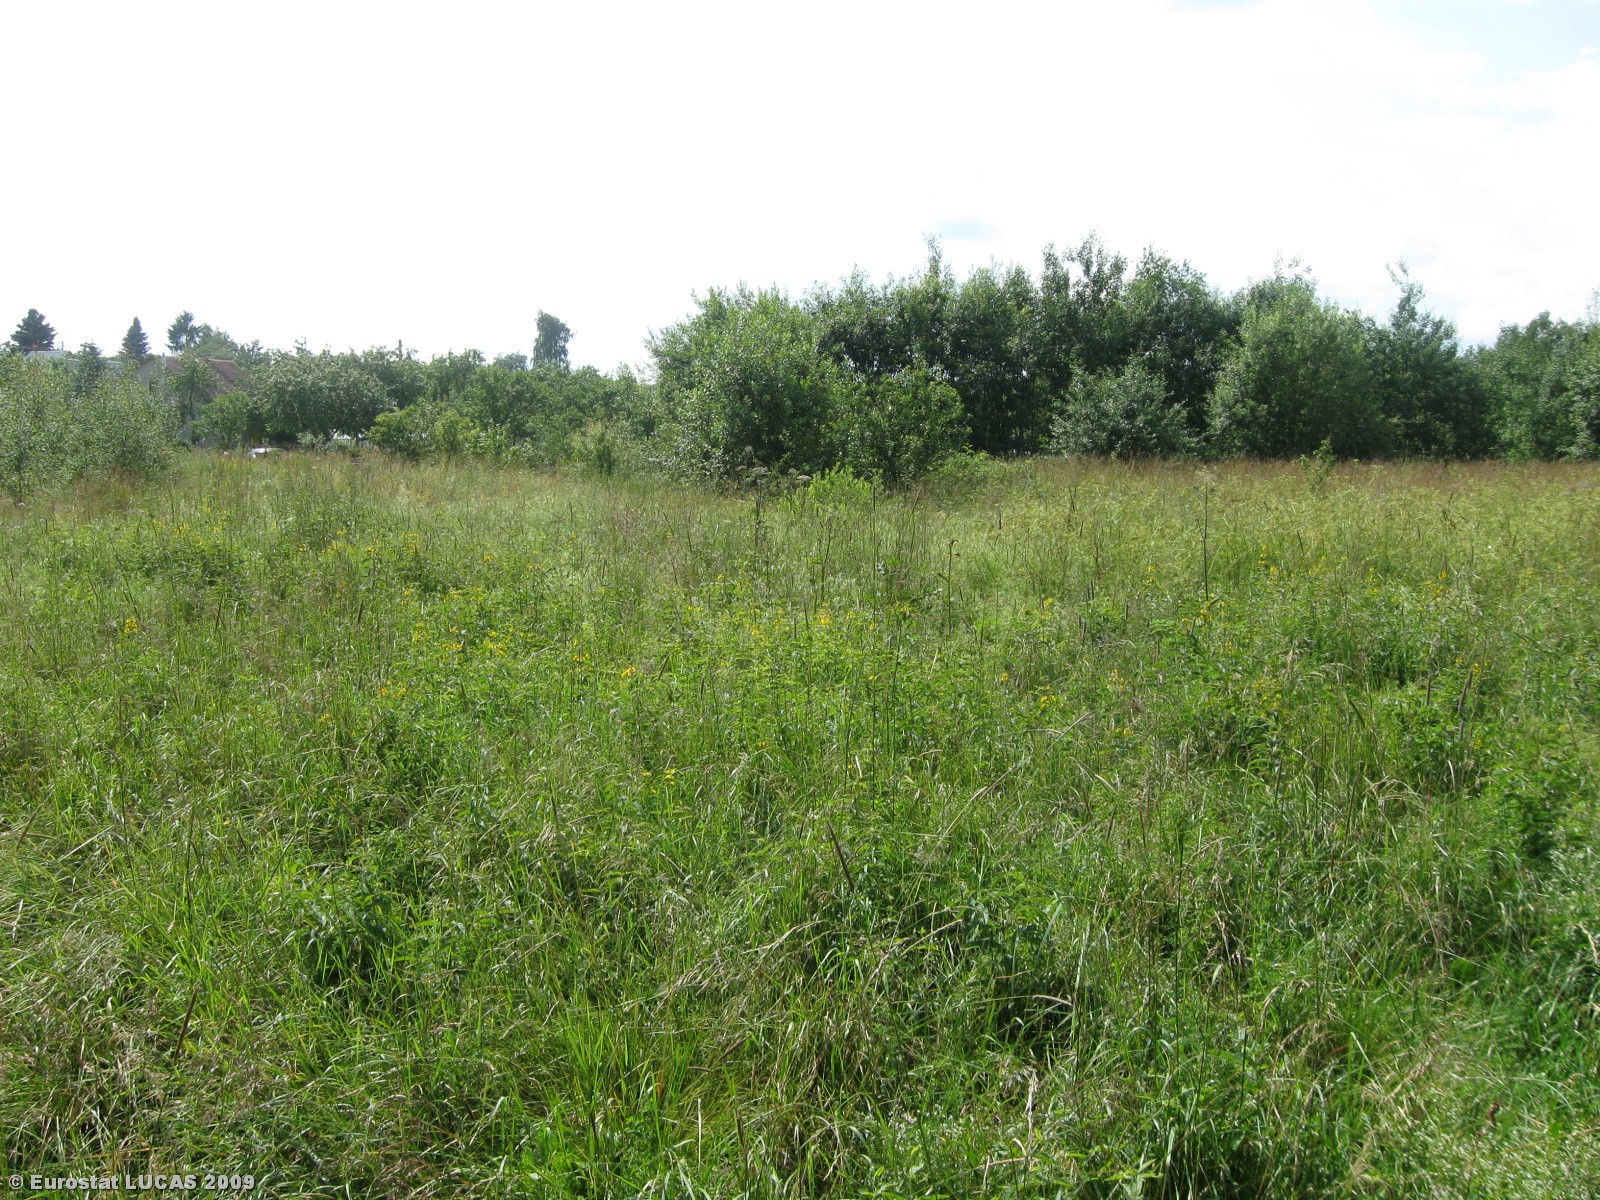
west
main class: Grassland
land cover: Grassland without tree/shrub cover
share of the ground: > 75 %
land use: Agriculture (excluding fallow land and kitchen gardens)
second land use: Amenities, museums, leisure
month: July
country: LT
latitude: 54.6224
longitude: 25.2841
